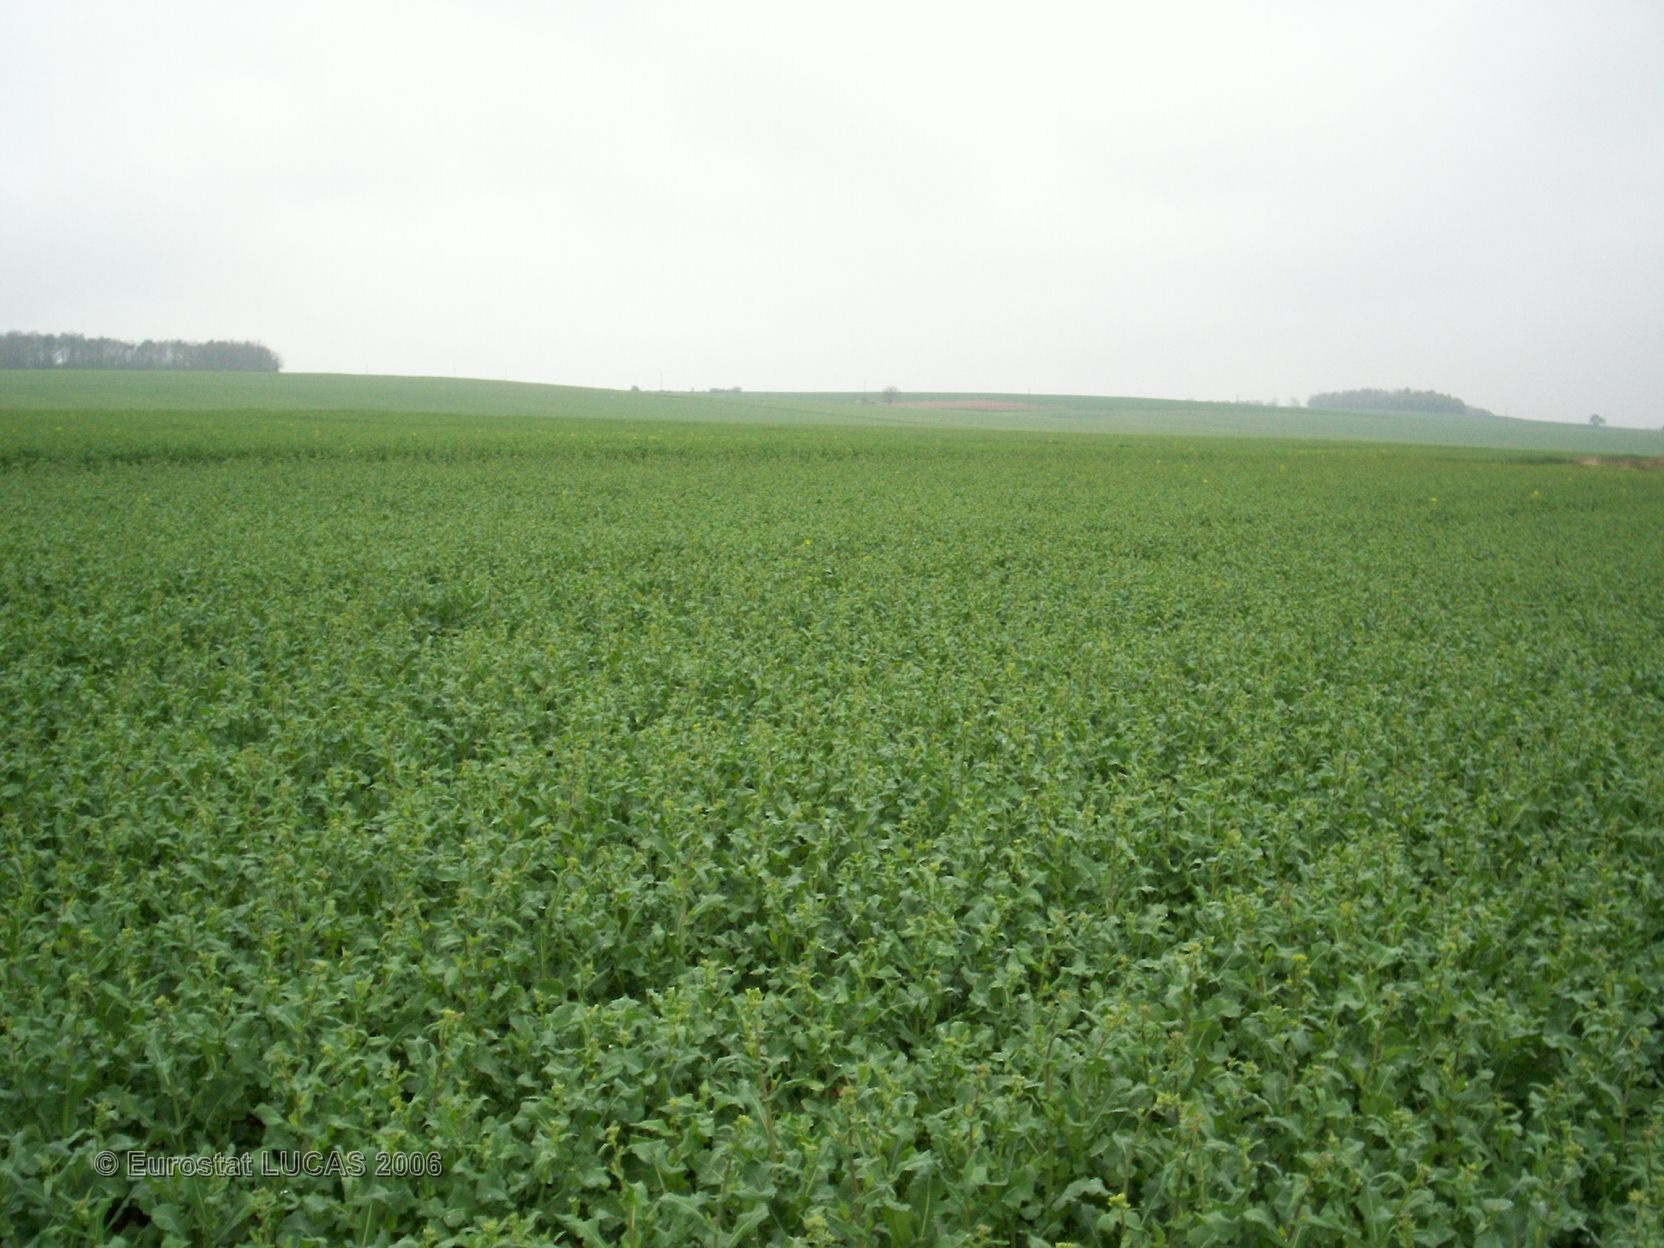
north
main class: Cropland
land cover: Rape and turnip rape
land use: Agriculture (excluding fallow land and kitchen gardens)
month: April
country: FR
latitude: 47.7983
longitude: 4.5113
